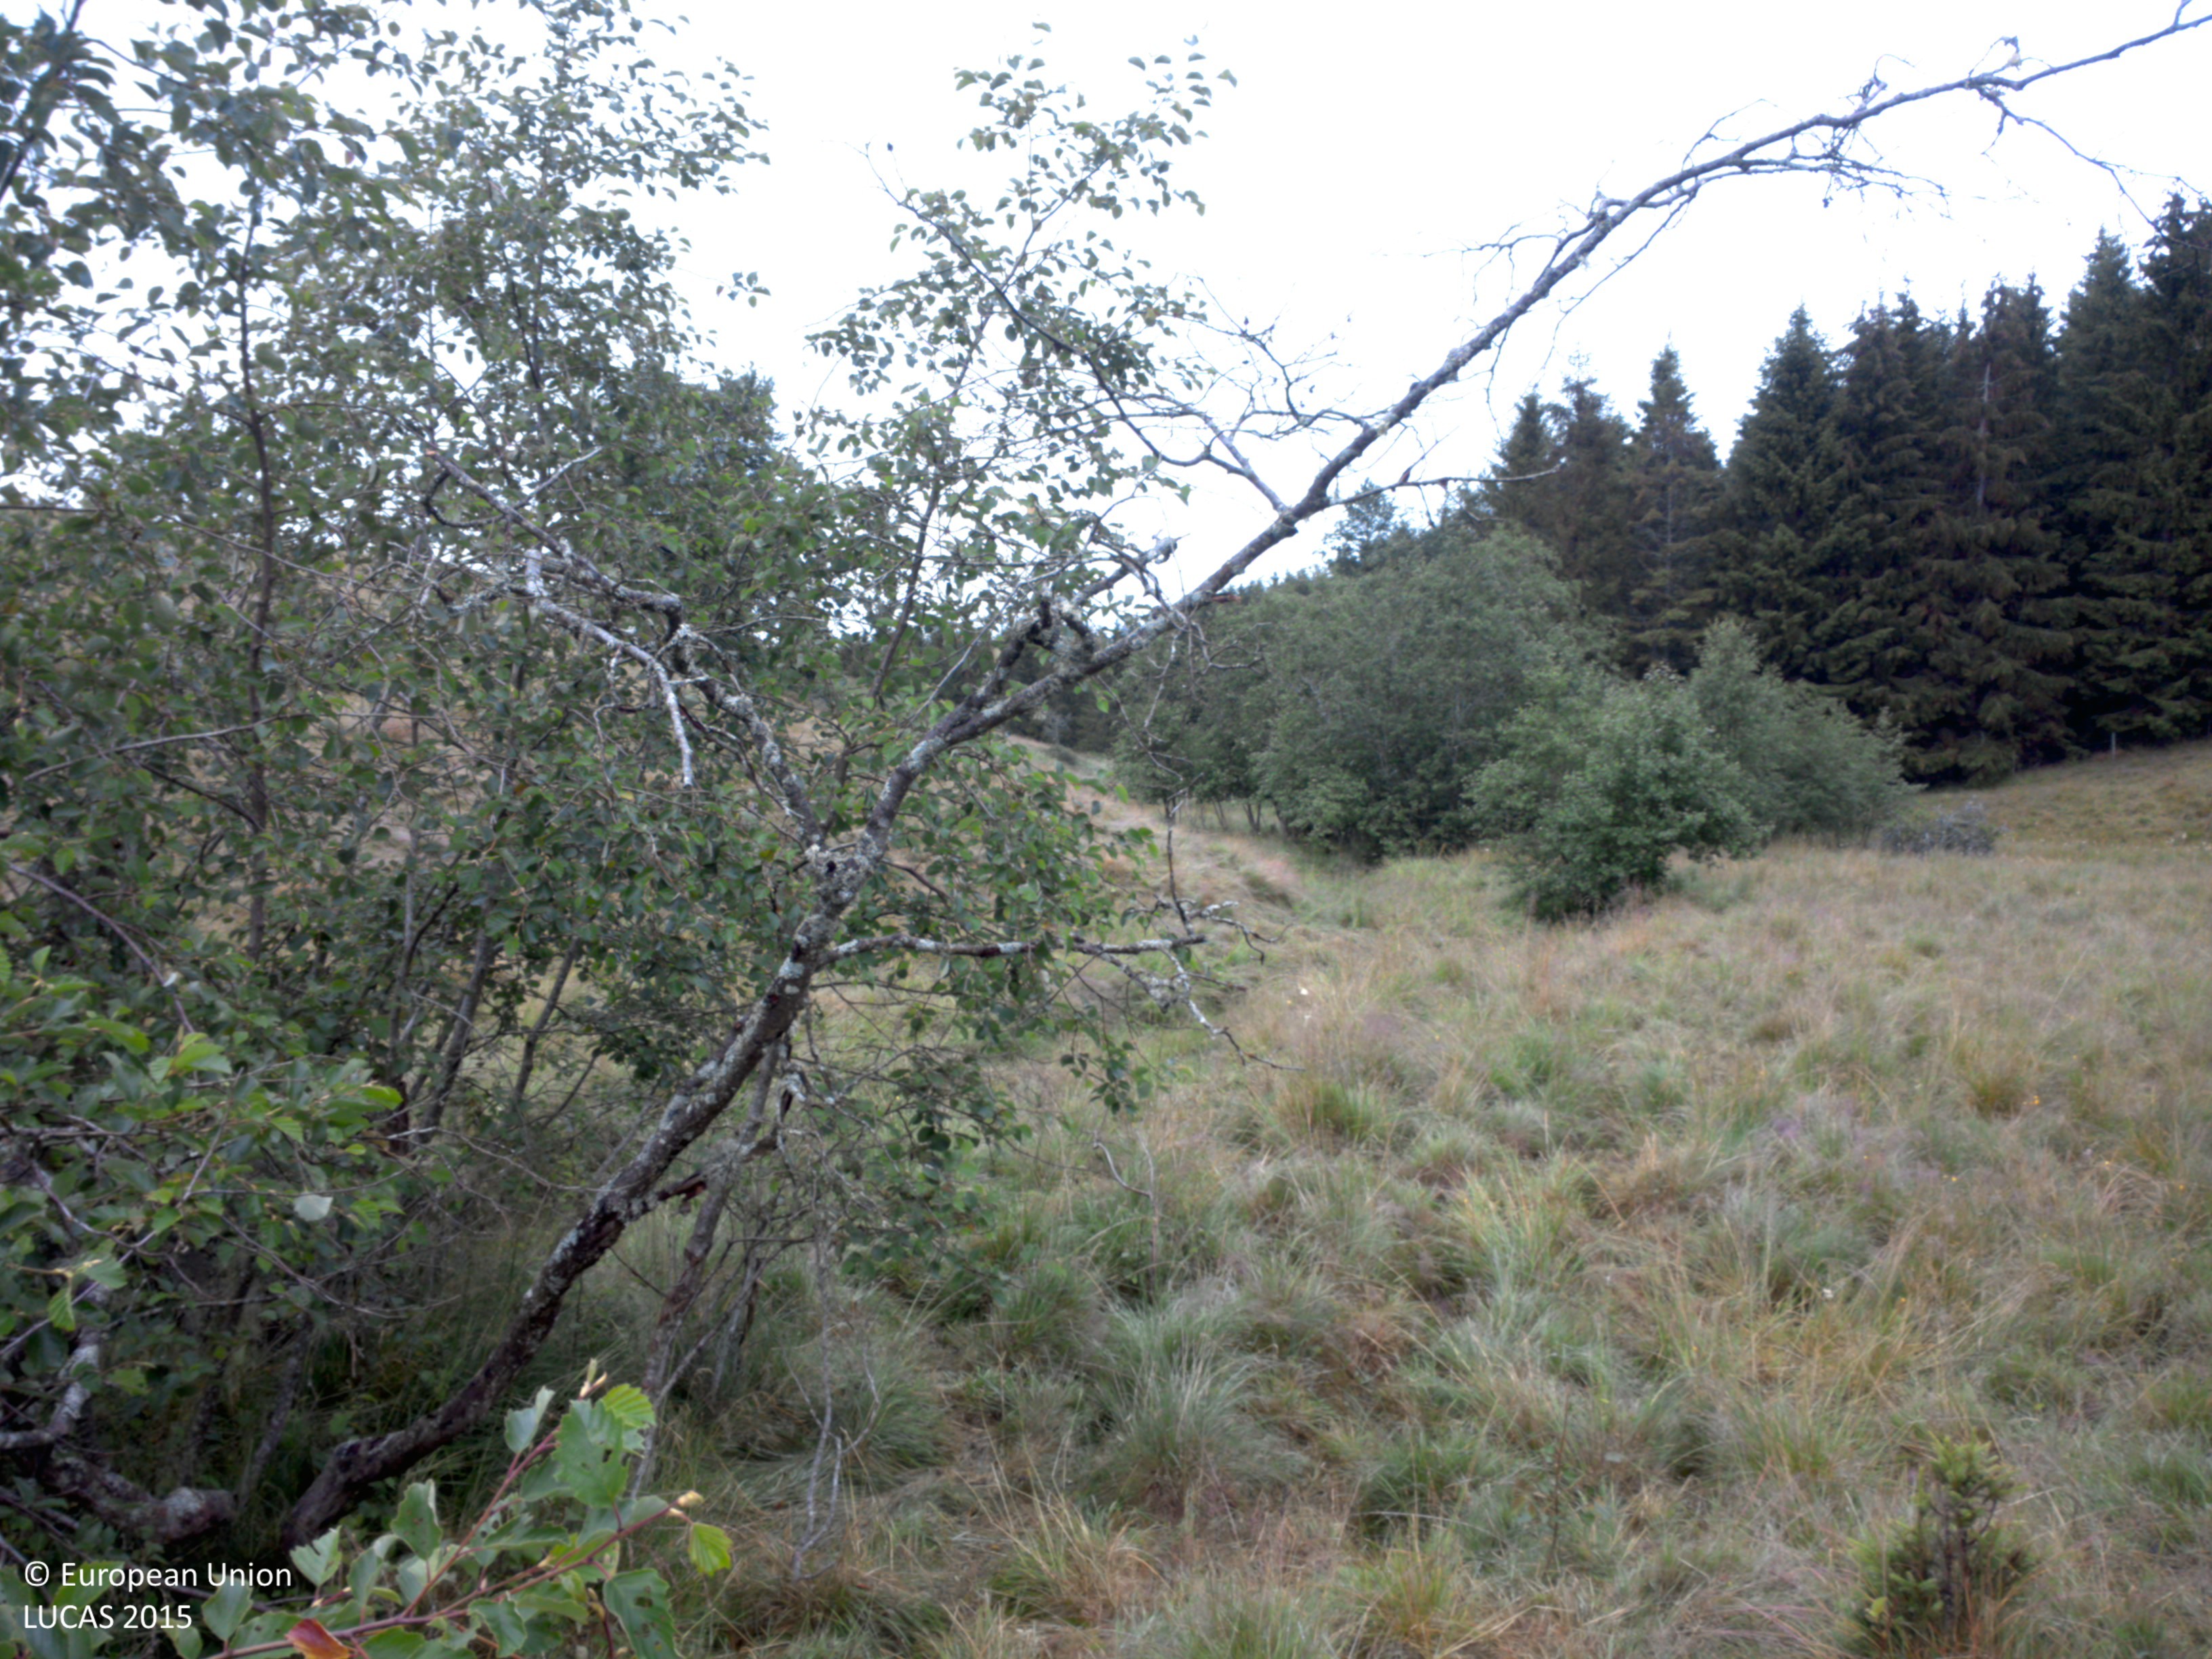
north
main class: Grassland
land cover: Grassland with sparse tree/shrub cover
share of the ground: > 75 %
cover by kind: herbaceous plants 95 %, coniferous forest trees 5 %
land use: Agriculture (excluding fallow land and kitchen gardens)
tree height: < 5 m
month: July
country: SE
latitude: 58.7291
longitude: 11.8095
